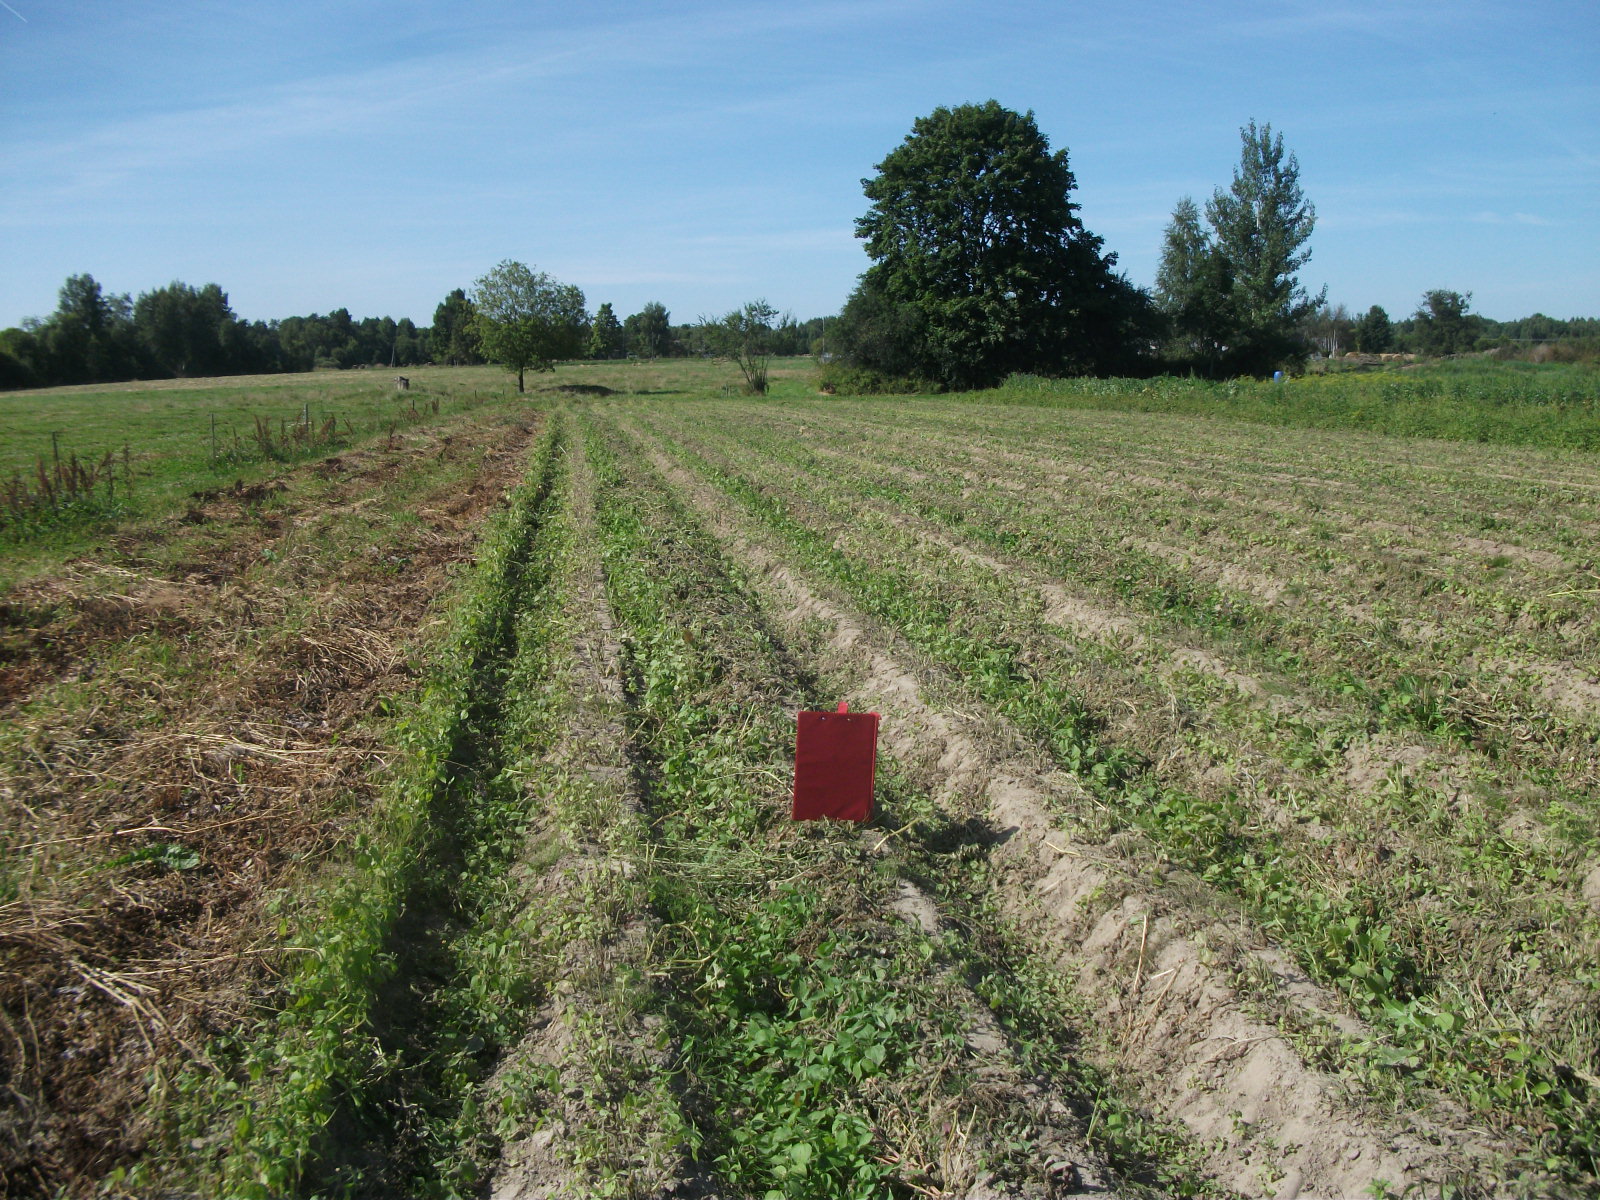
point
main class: Cropland
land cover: Potatoes
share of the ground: < 10 %
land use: Agriculture (excluding fallow land and kitchen gardens)
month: August
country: LV
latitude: 56.2043
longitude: 26.2789
